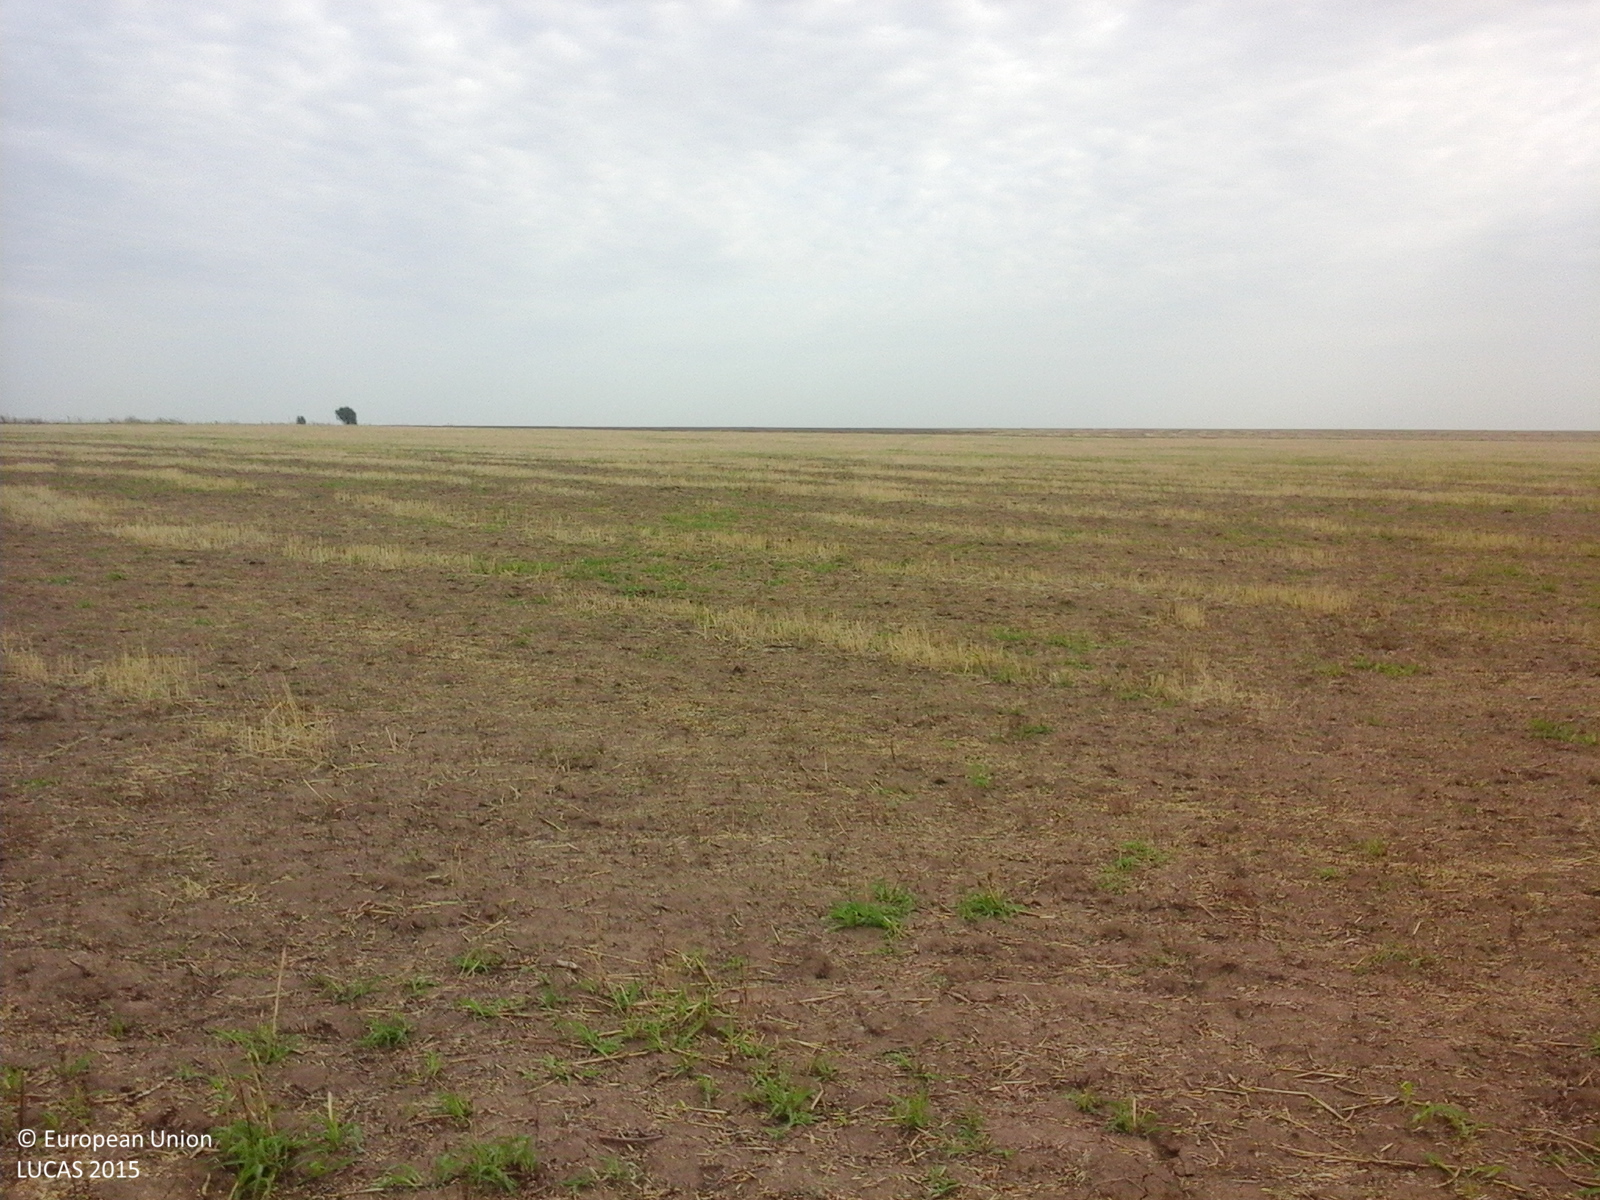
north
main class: Cropland
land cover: Common wheat
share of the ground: < 10 %
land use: Agriculture (excluding fallow land and kitchen gardens)
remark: Burnt area
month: August
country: RO
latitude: 44.1101
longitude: 28.4976
